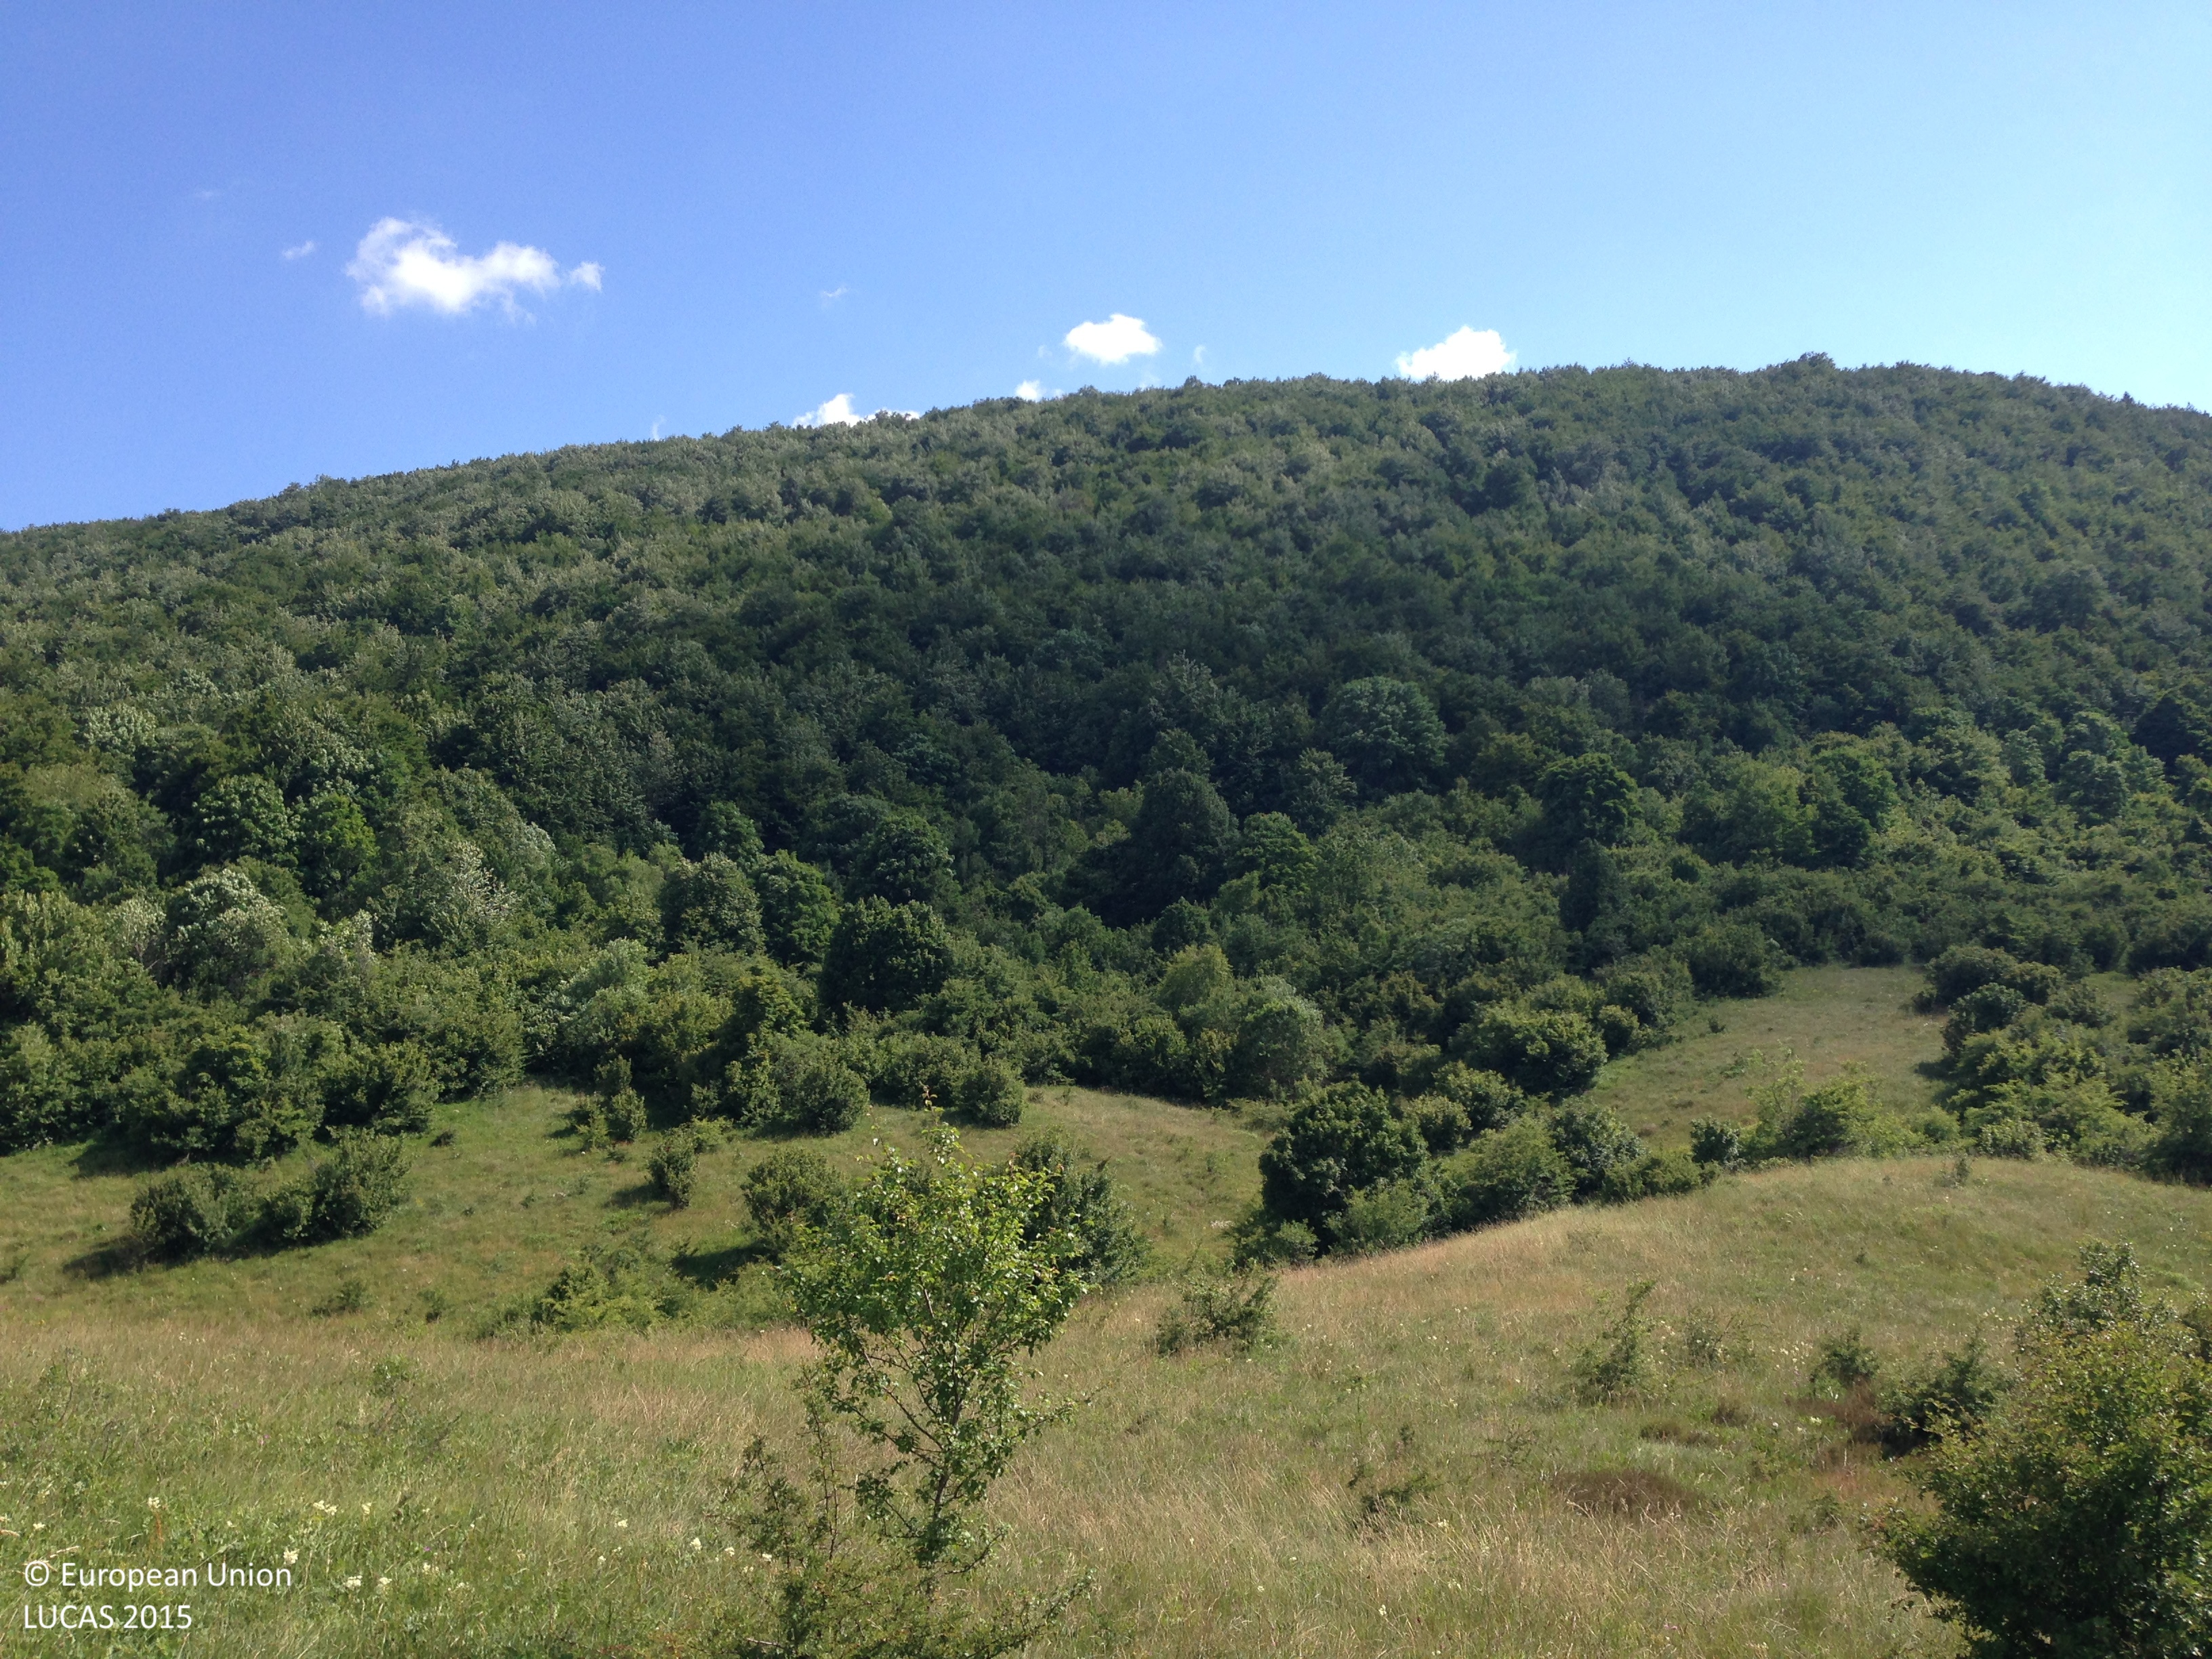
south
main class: Grassland
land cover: Grassland with sparse tree/shrub cover
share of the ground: > 75 %
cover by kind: herbaceous plants 85 %, broadleaved forest trees 5 %, shrubs 5 %, unconsolidated bare surface 5 %
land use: Agriculture (excluding fallow land and kitchen gardens)
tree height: < 5 m
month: June
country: HR
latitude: 44.7587
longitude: 15.6159
